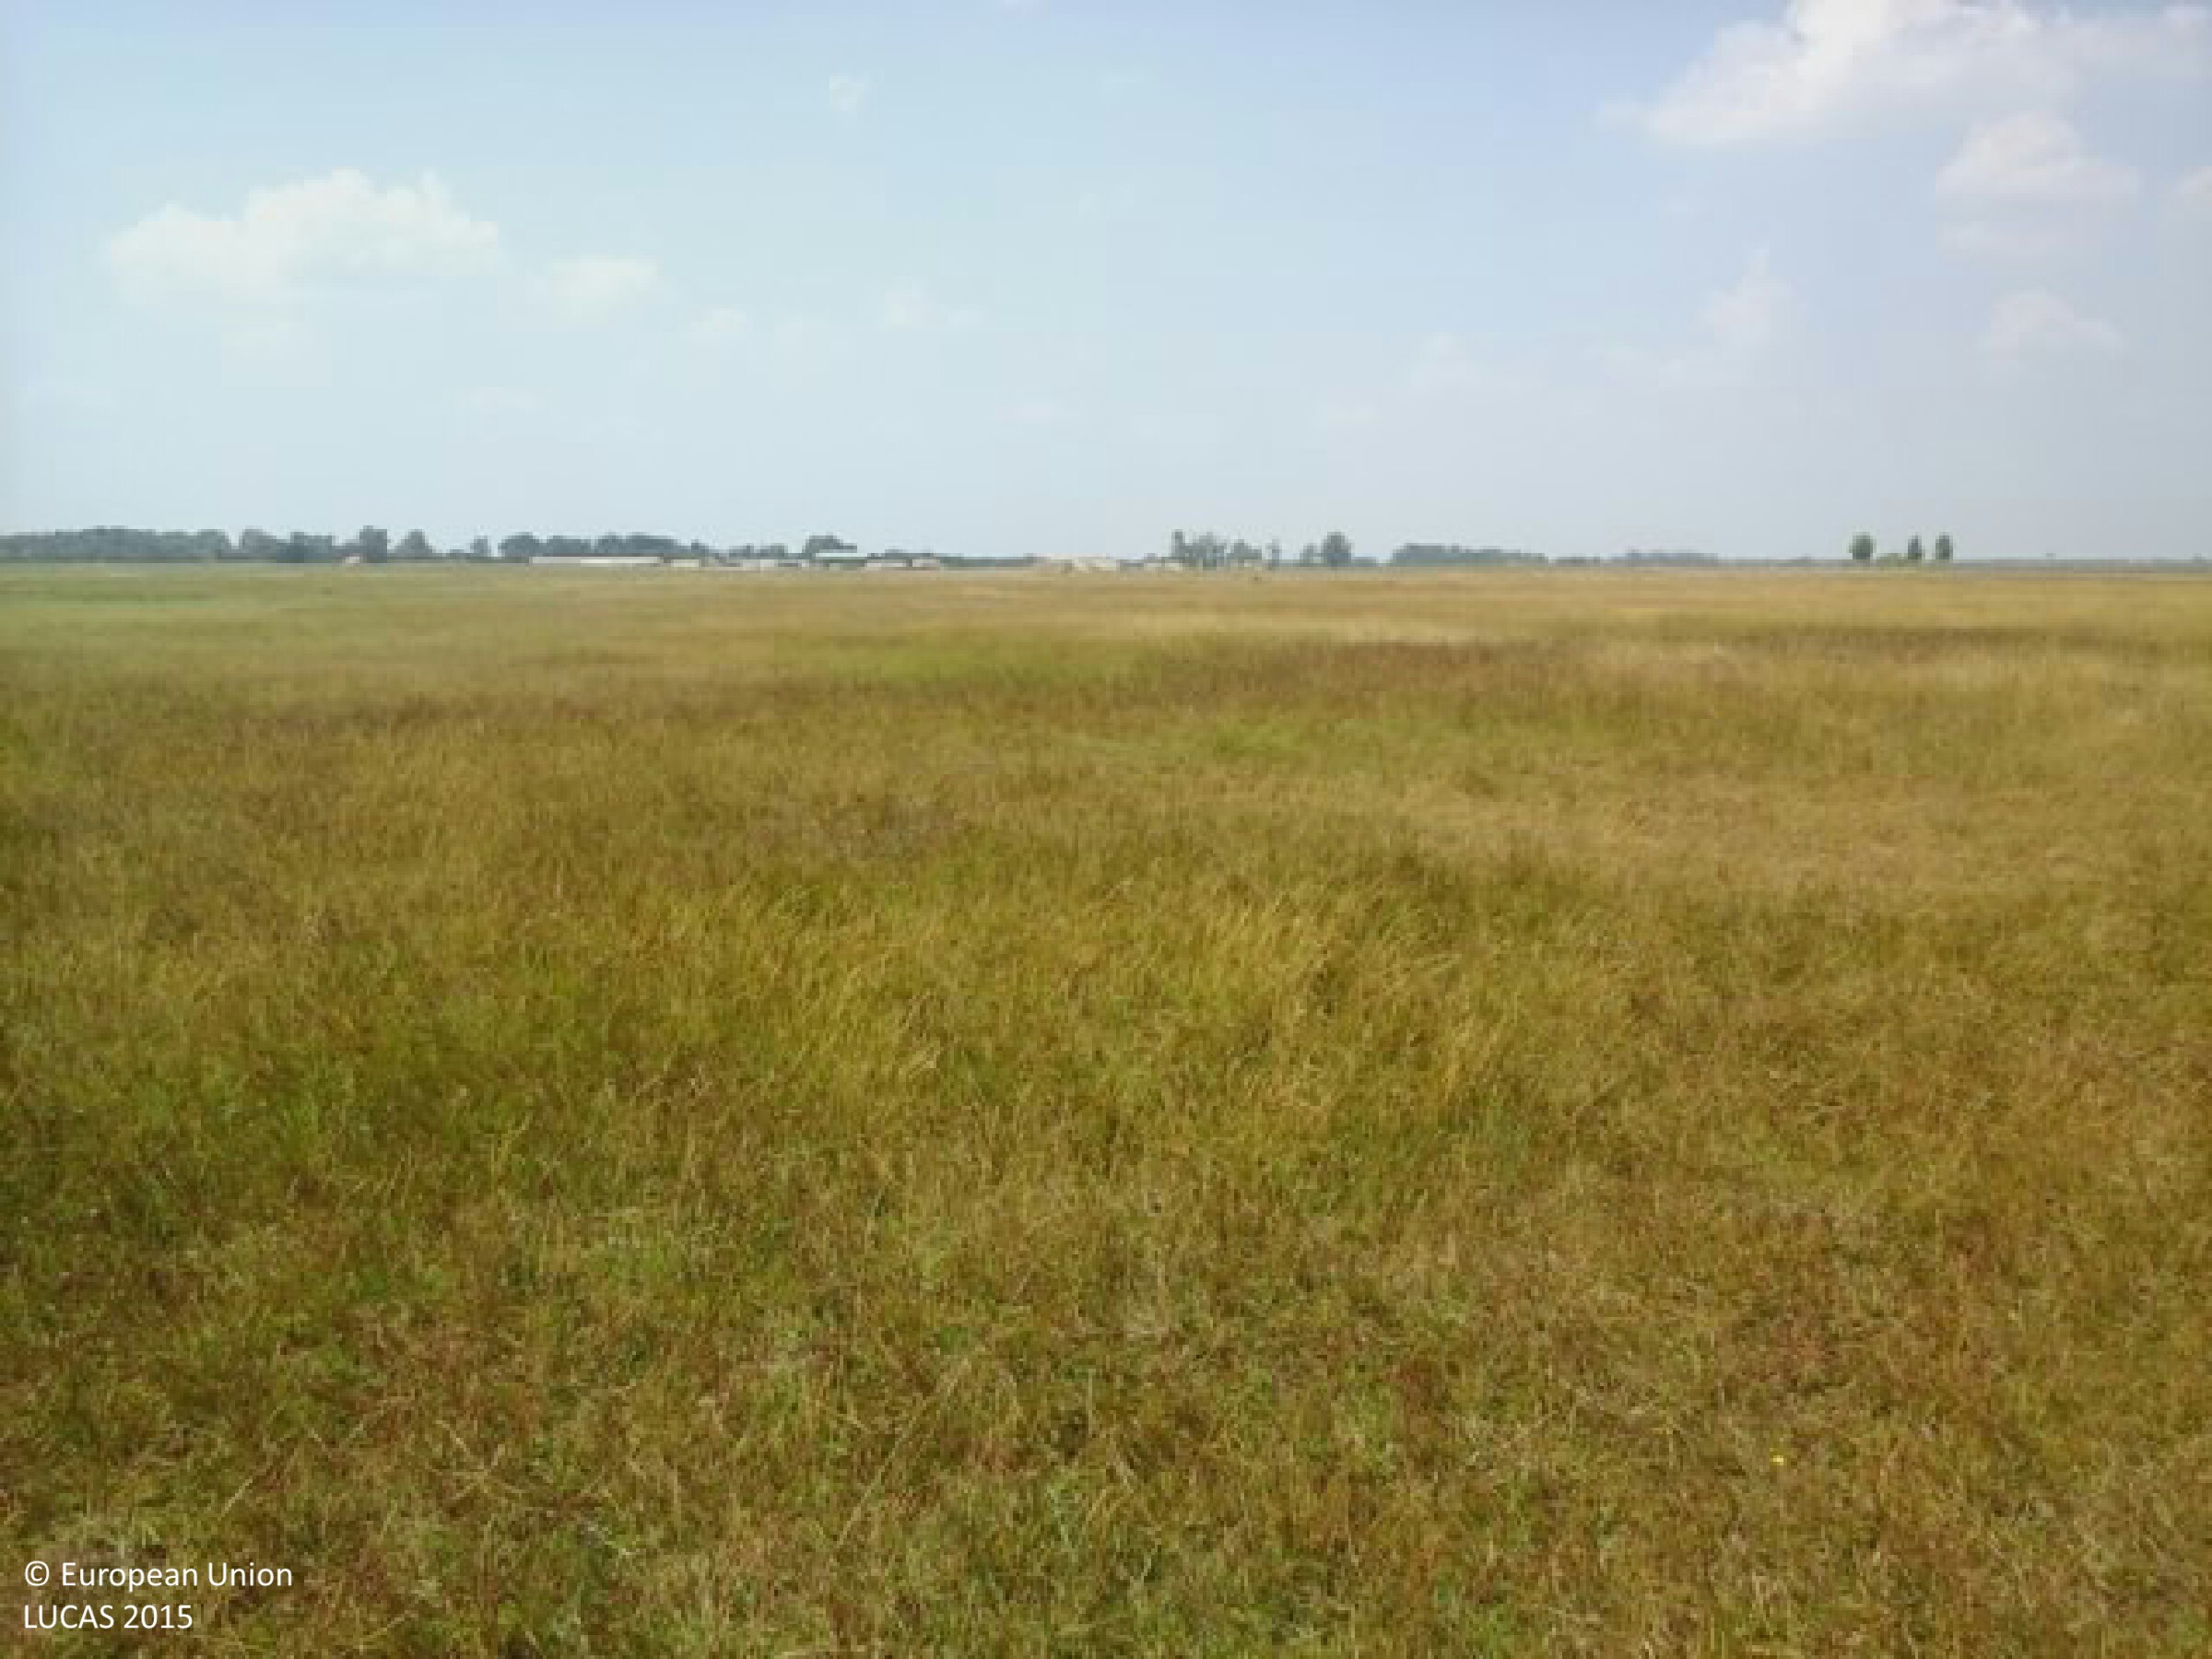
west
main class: Grassland
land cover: Grassland without tree/shrub cover
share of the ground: > 75 %
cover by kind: herbaceous plants 100 %
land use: Agriculture (excluding fallow land and kitchen gardens)
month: August
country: HU
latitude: 47.0709
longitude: 19.0631
